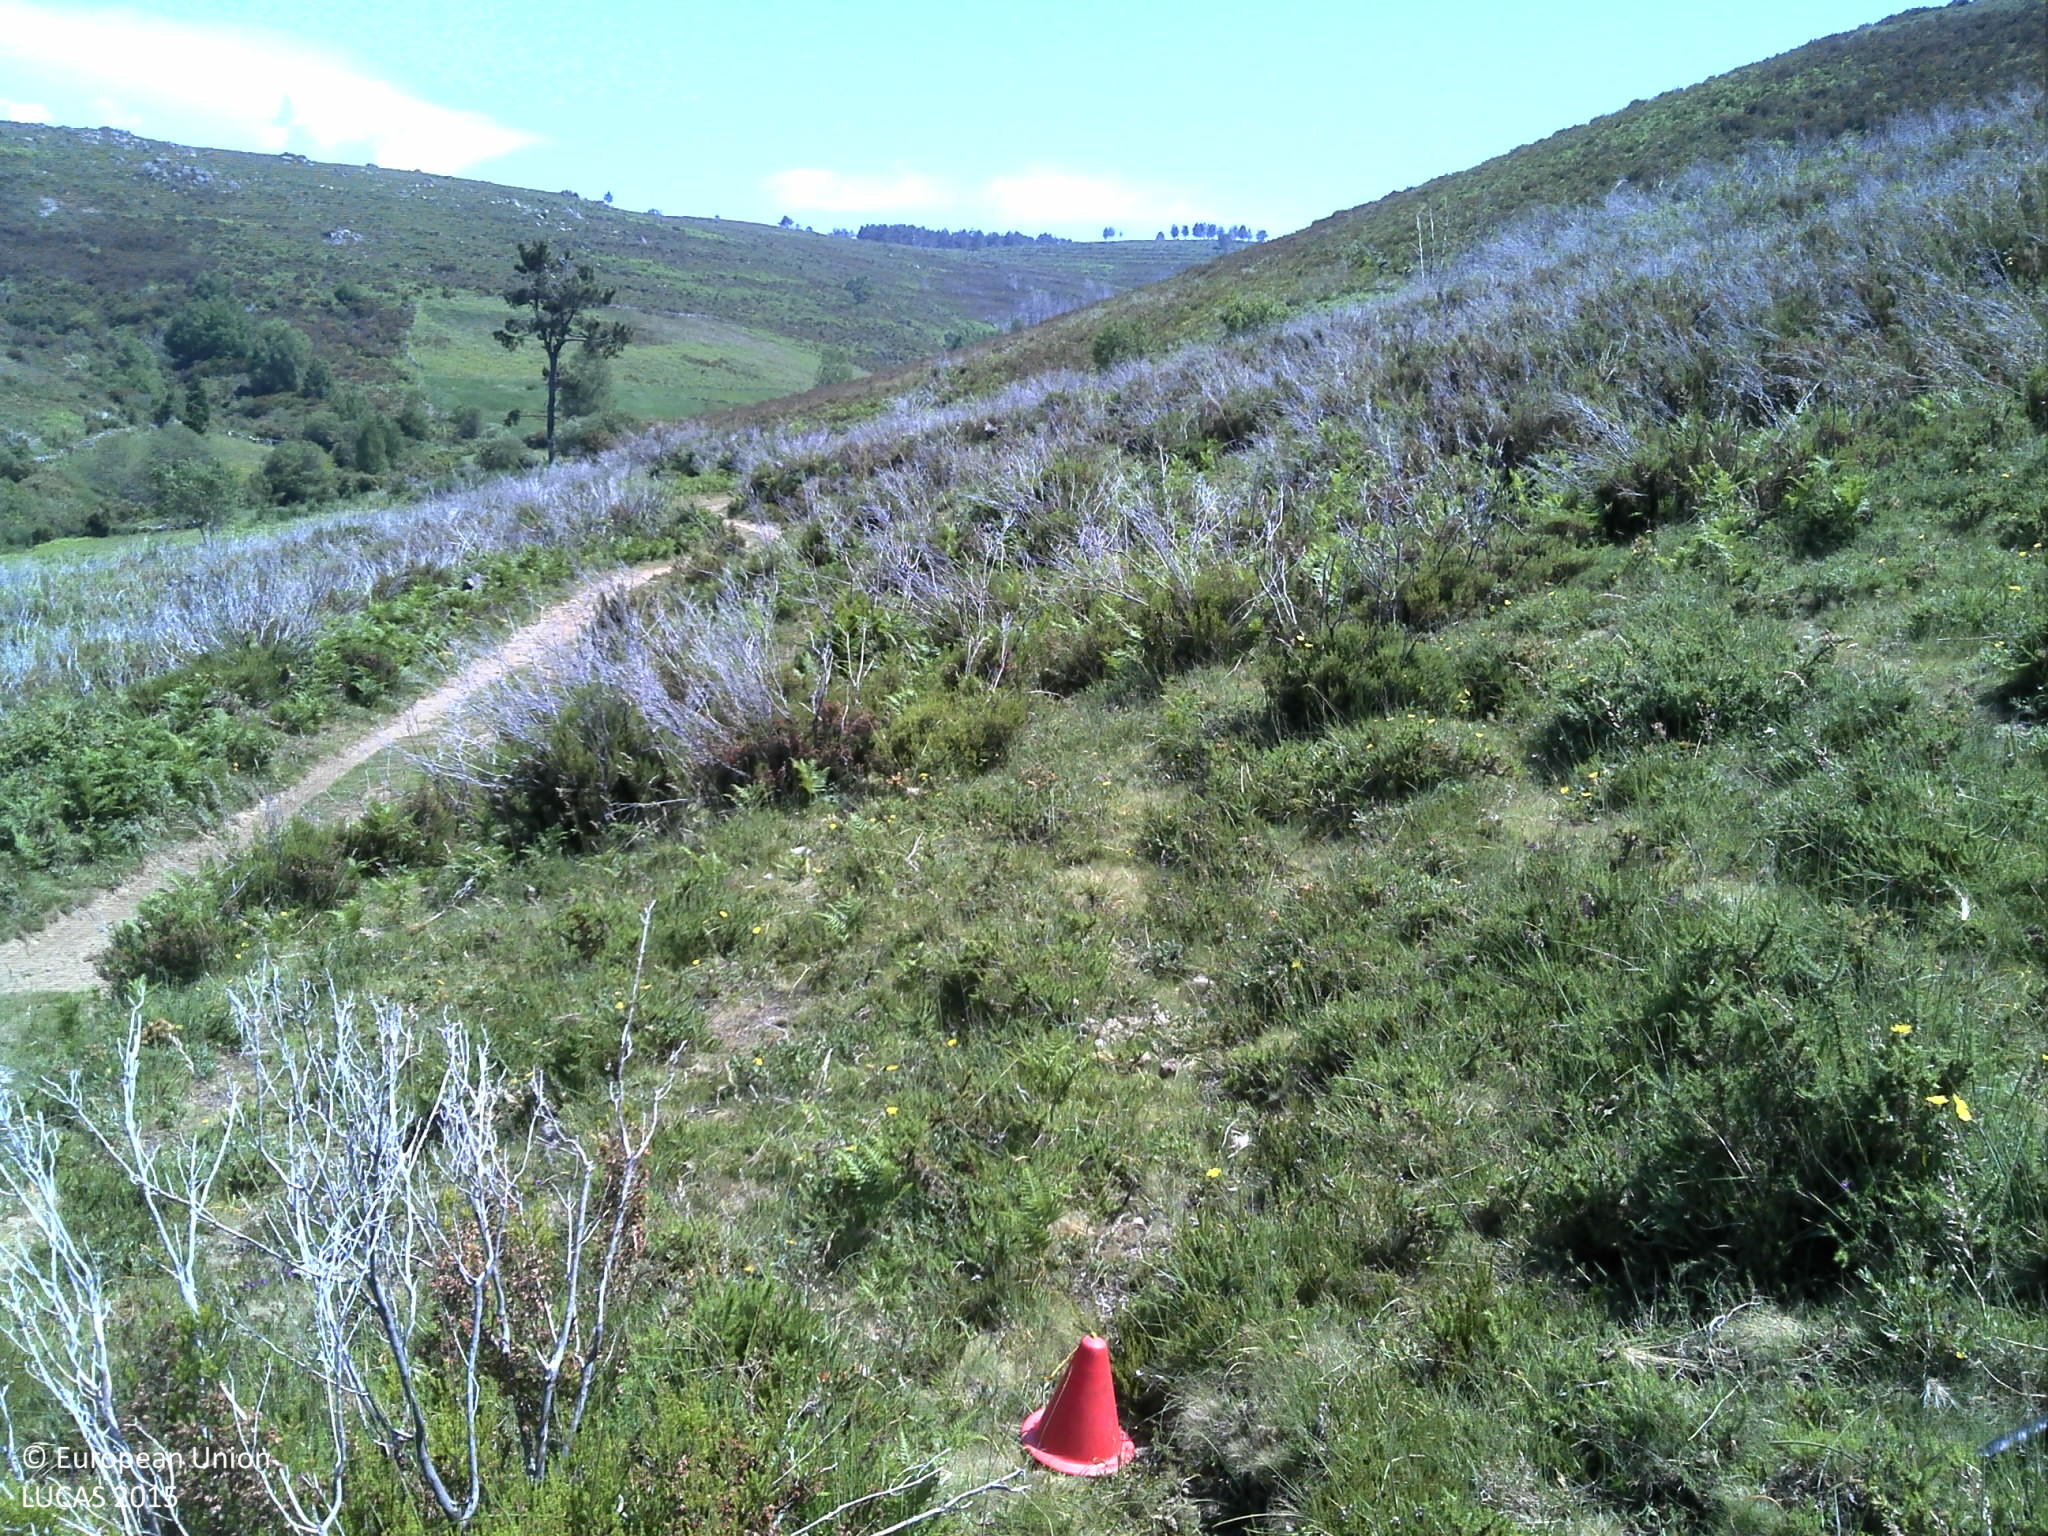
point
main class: Shrubland
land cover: Shrubland without tree cover
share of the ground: 25 - 50 %
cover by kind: shrubs 50 %, herbaceous plants 45 %, unconsolidated bare surface 5 %
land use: Agriculture (excluding fallow land and kitchen gardens)
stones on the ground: 10 - 25 %
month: June
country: PT
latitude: 41.9904
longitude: -8.2750
